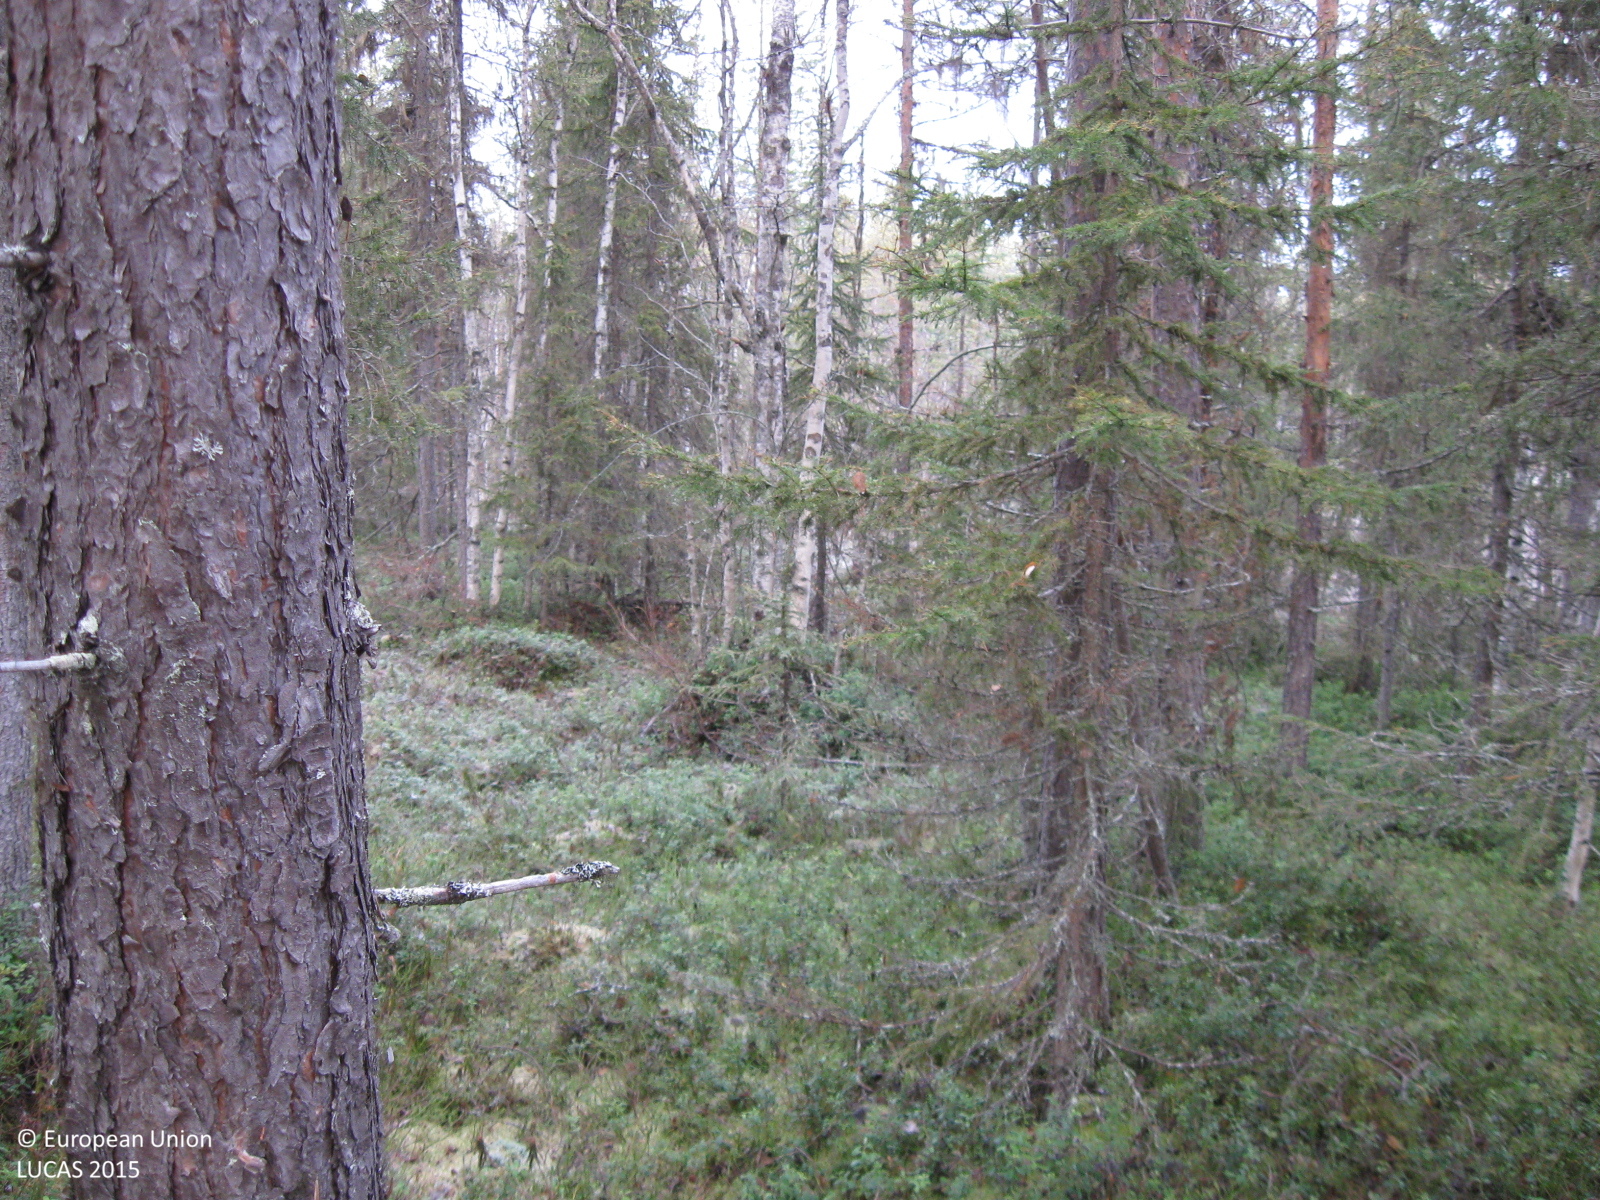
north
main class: Woodland
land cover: Other mixed woodland
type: boreal forest
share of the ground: > 75 %
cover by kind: coniferous forest trees 60 %, broadleaved forest trees 25 %, shrubs 5 %, herbaceous plants 5 %, lichens and mosses 5 %
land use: Forestry
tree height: > 5 m
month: October
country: SE
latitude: 66.2481
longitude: 21.5132
